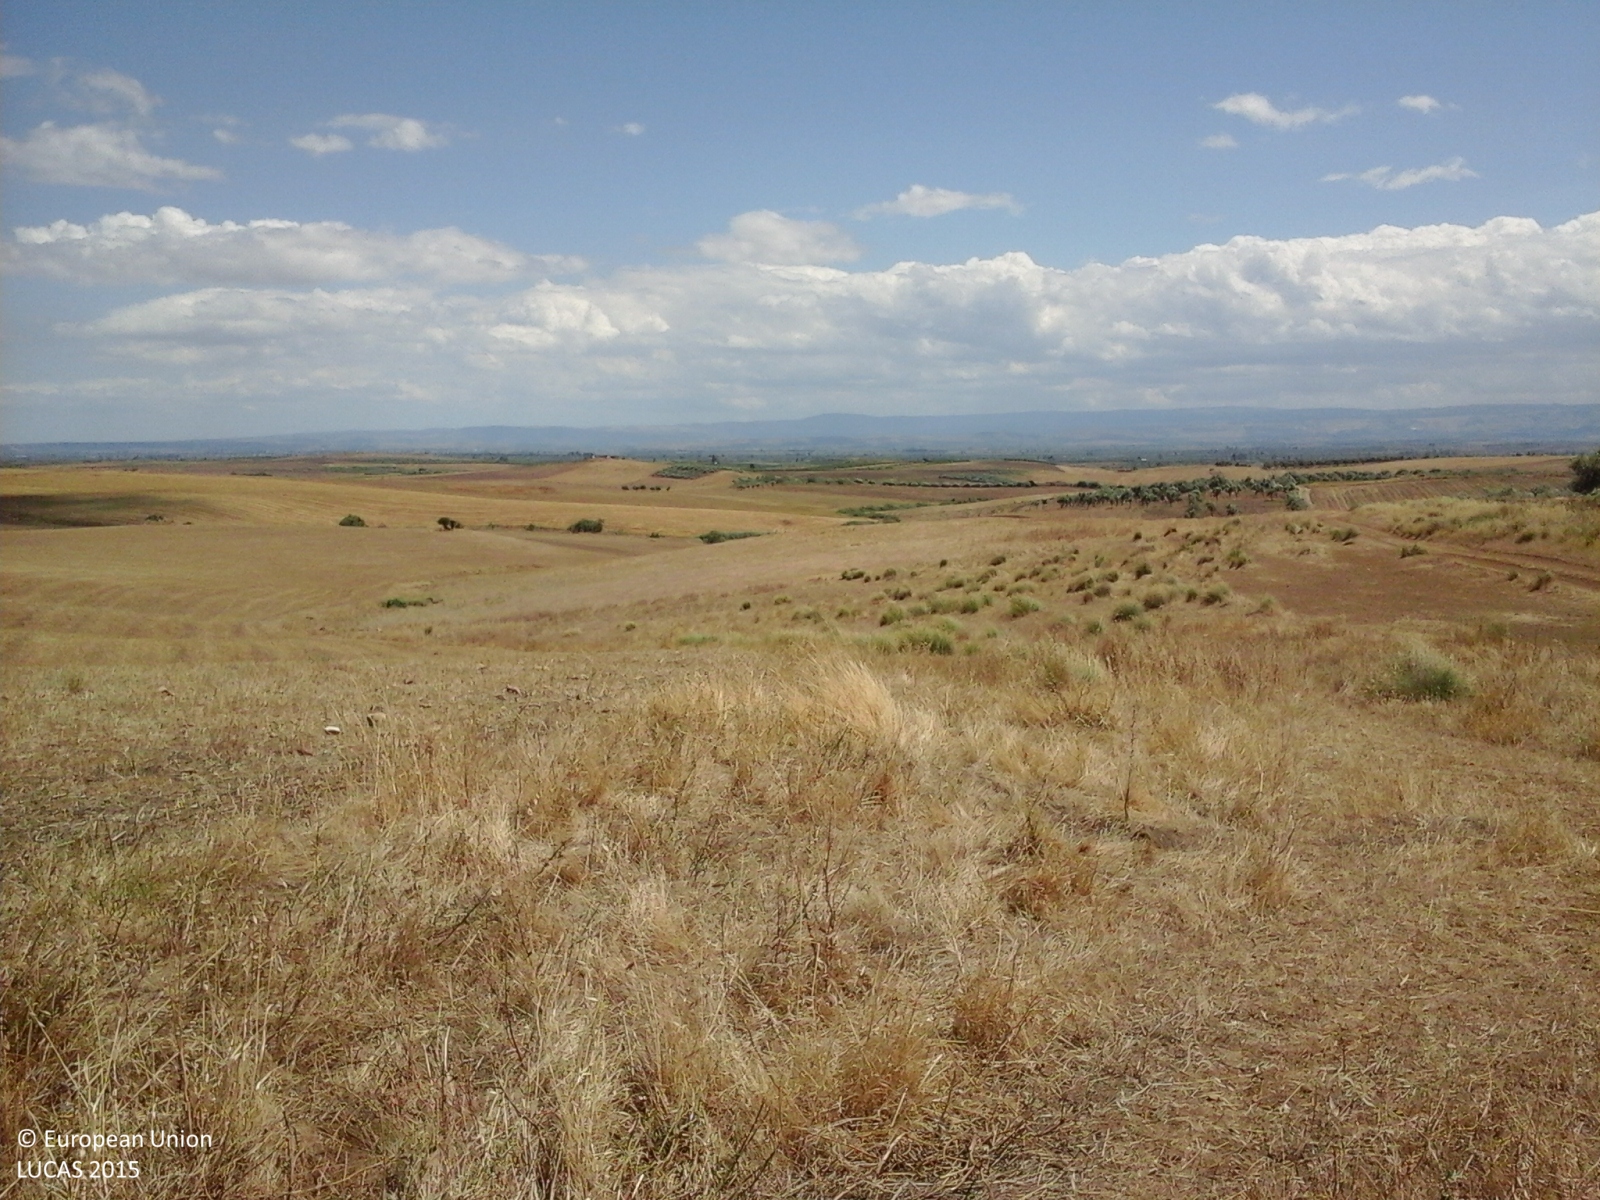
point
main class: Cropland
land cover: Mixed cereals for fodder
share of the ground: > 75 %
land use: Agriculture (excluding fallow land and kitchen gardens)
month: June
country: IT
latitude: 37.5344
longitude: 14.8201
